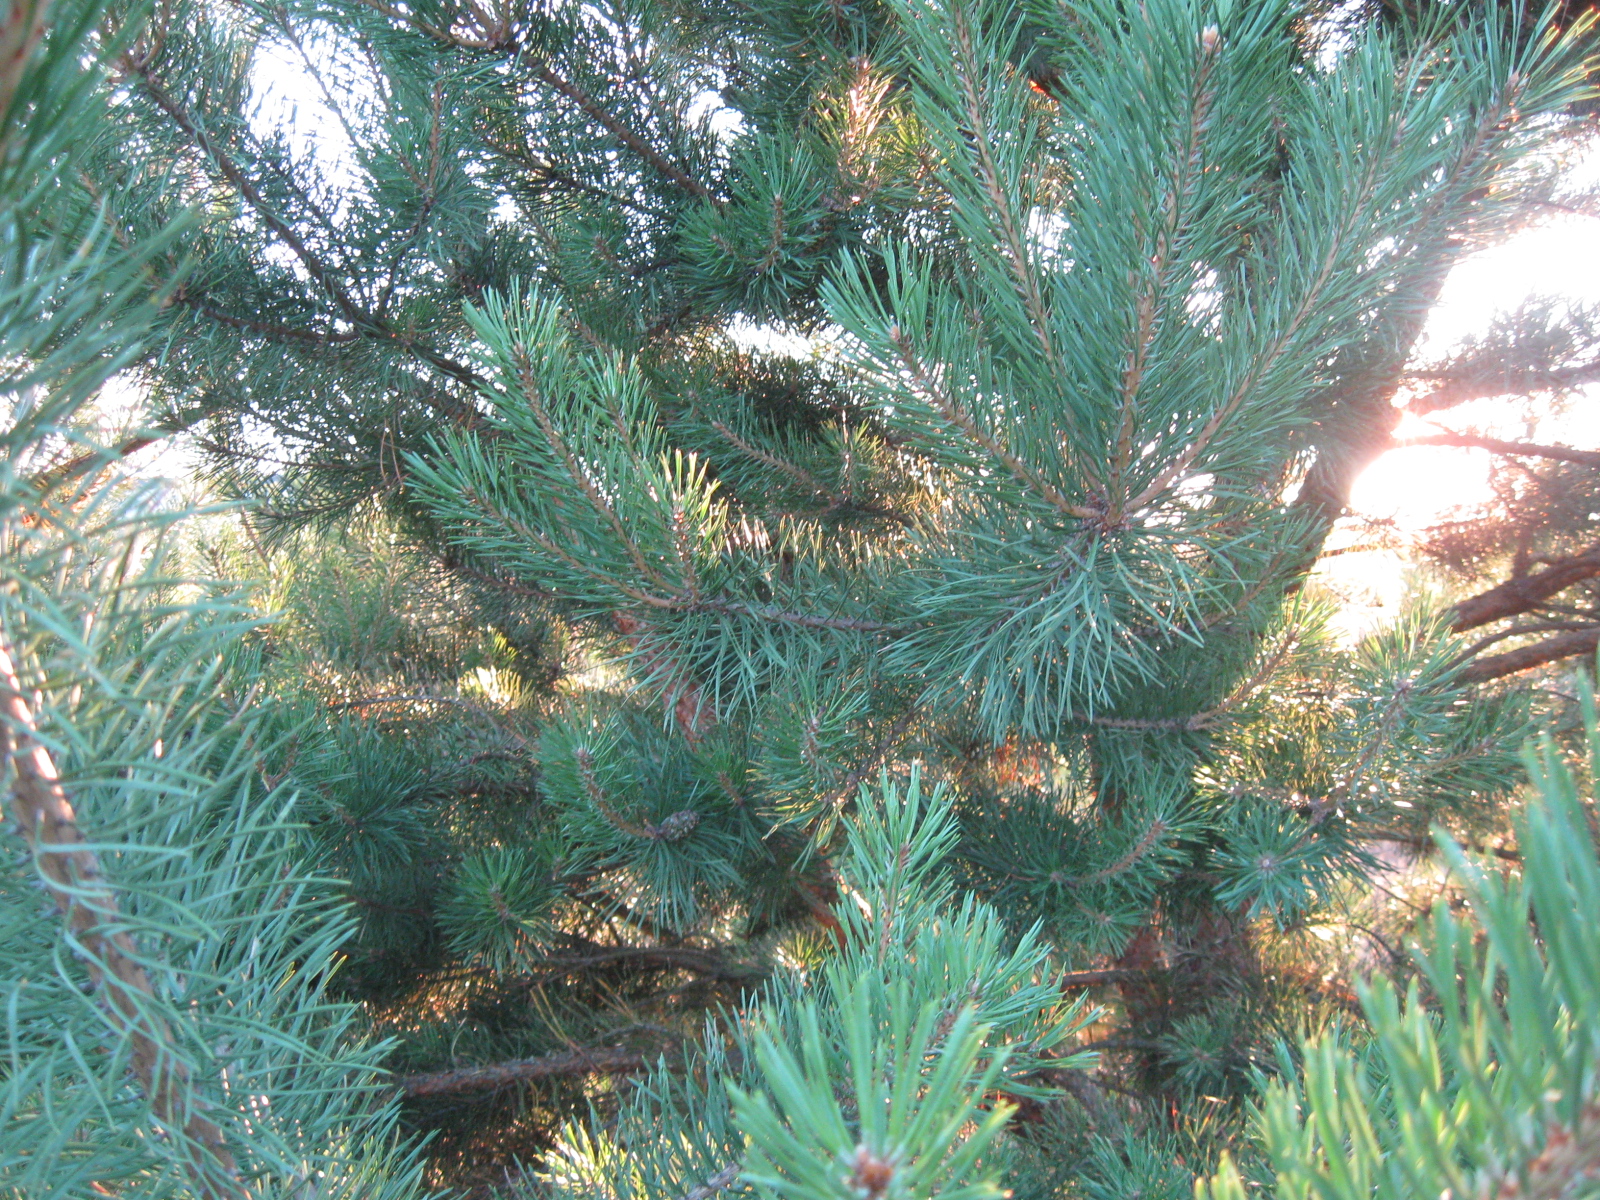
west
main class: Woodland
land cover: Pine dominated coniferous woodland
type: hemiboreal forest and nemoral coniferous forest and mixed broadleaved-coniferous forest
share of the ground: 25 - 50 %
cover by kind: herbaceous plants 55 %, coniferous forest trees 45 %
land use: Forestry
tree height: < 5 m
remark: Nursery
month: July
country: LT
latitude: 54.0956
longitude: 23.7110
